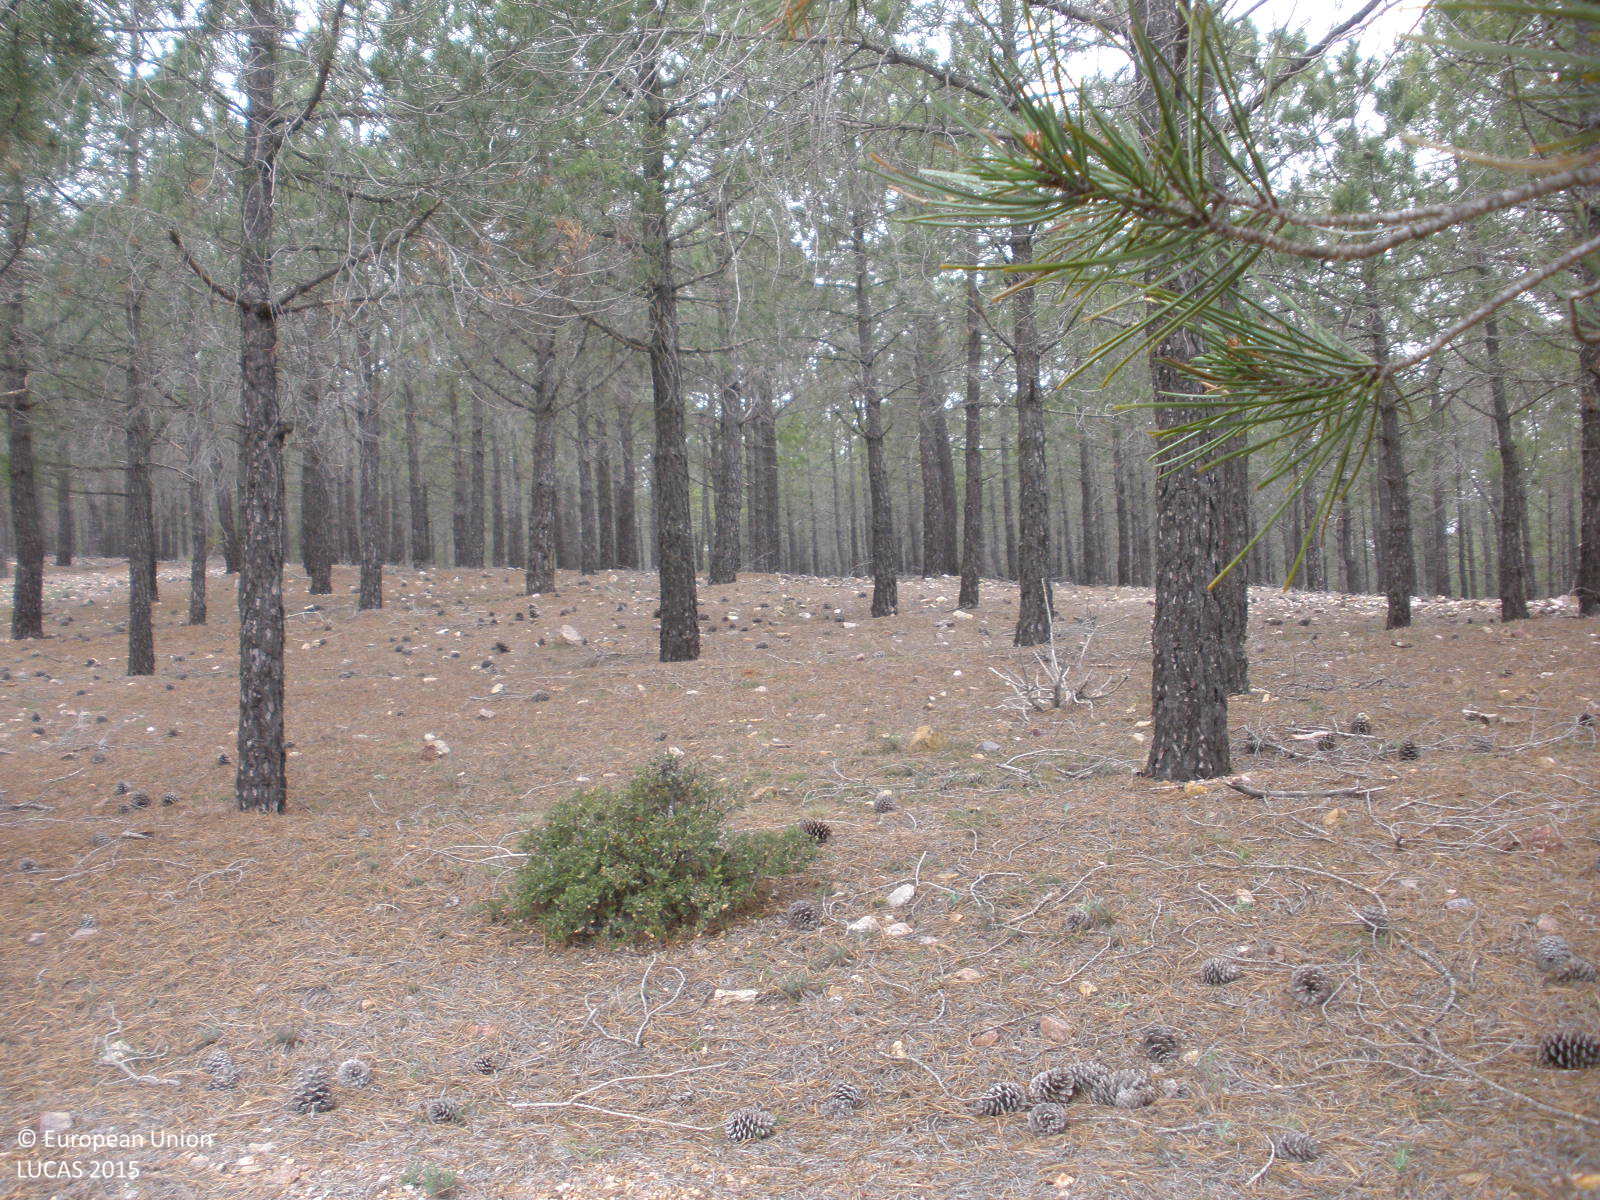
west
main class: Woodland
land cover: Pine dominated coniferous woodland
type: coniferous forest of the mediterranean region
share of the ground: 50 - 75 %
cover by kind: coniferous forest trees 70 %, consolidated bare surface 20 %, shrubs 10 %
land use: Semi-natural and natural areas not in use
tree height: > 5 m
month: April
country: ES
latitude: 40.3144
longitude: -1.2255
